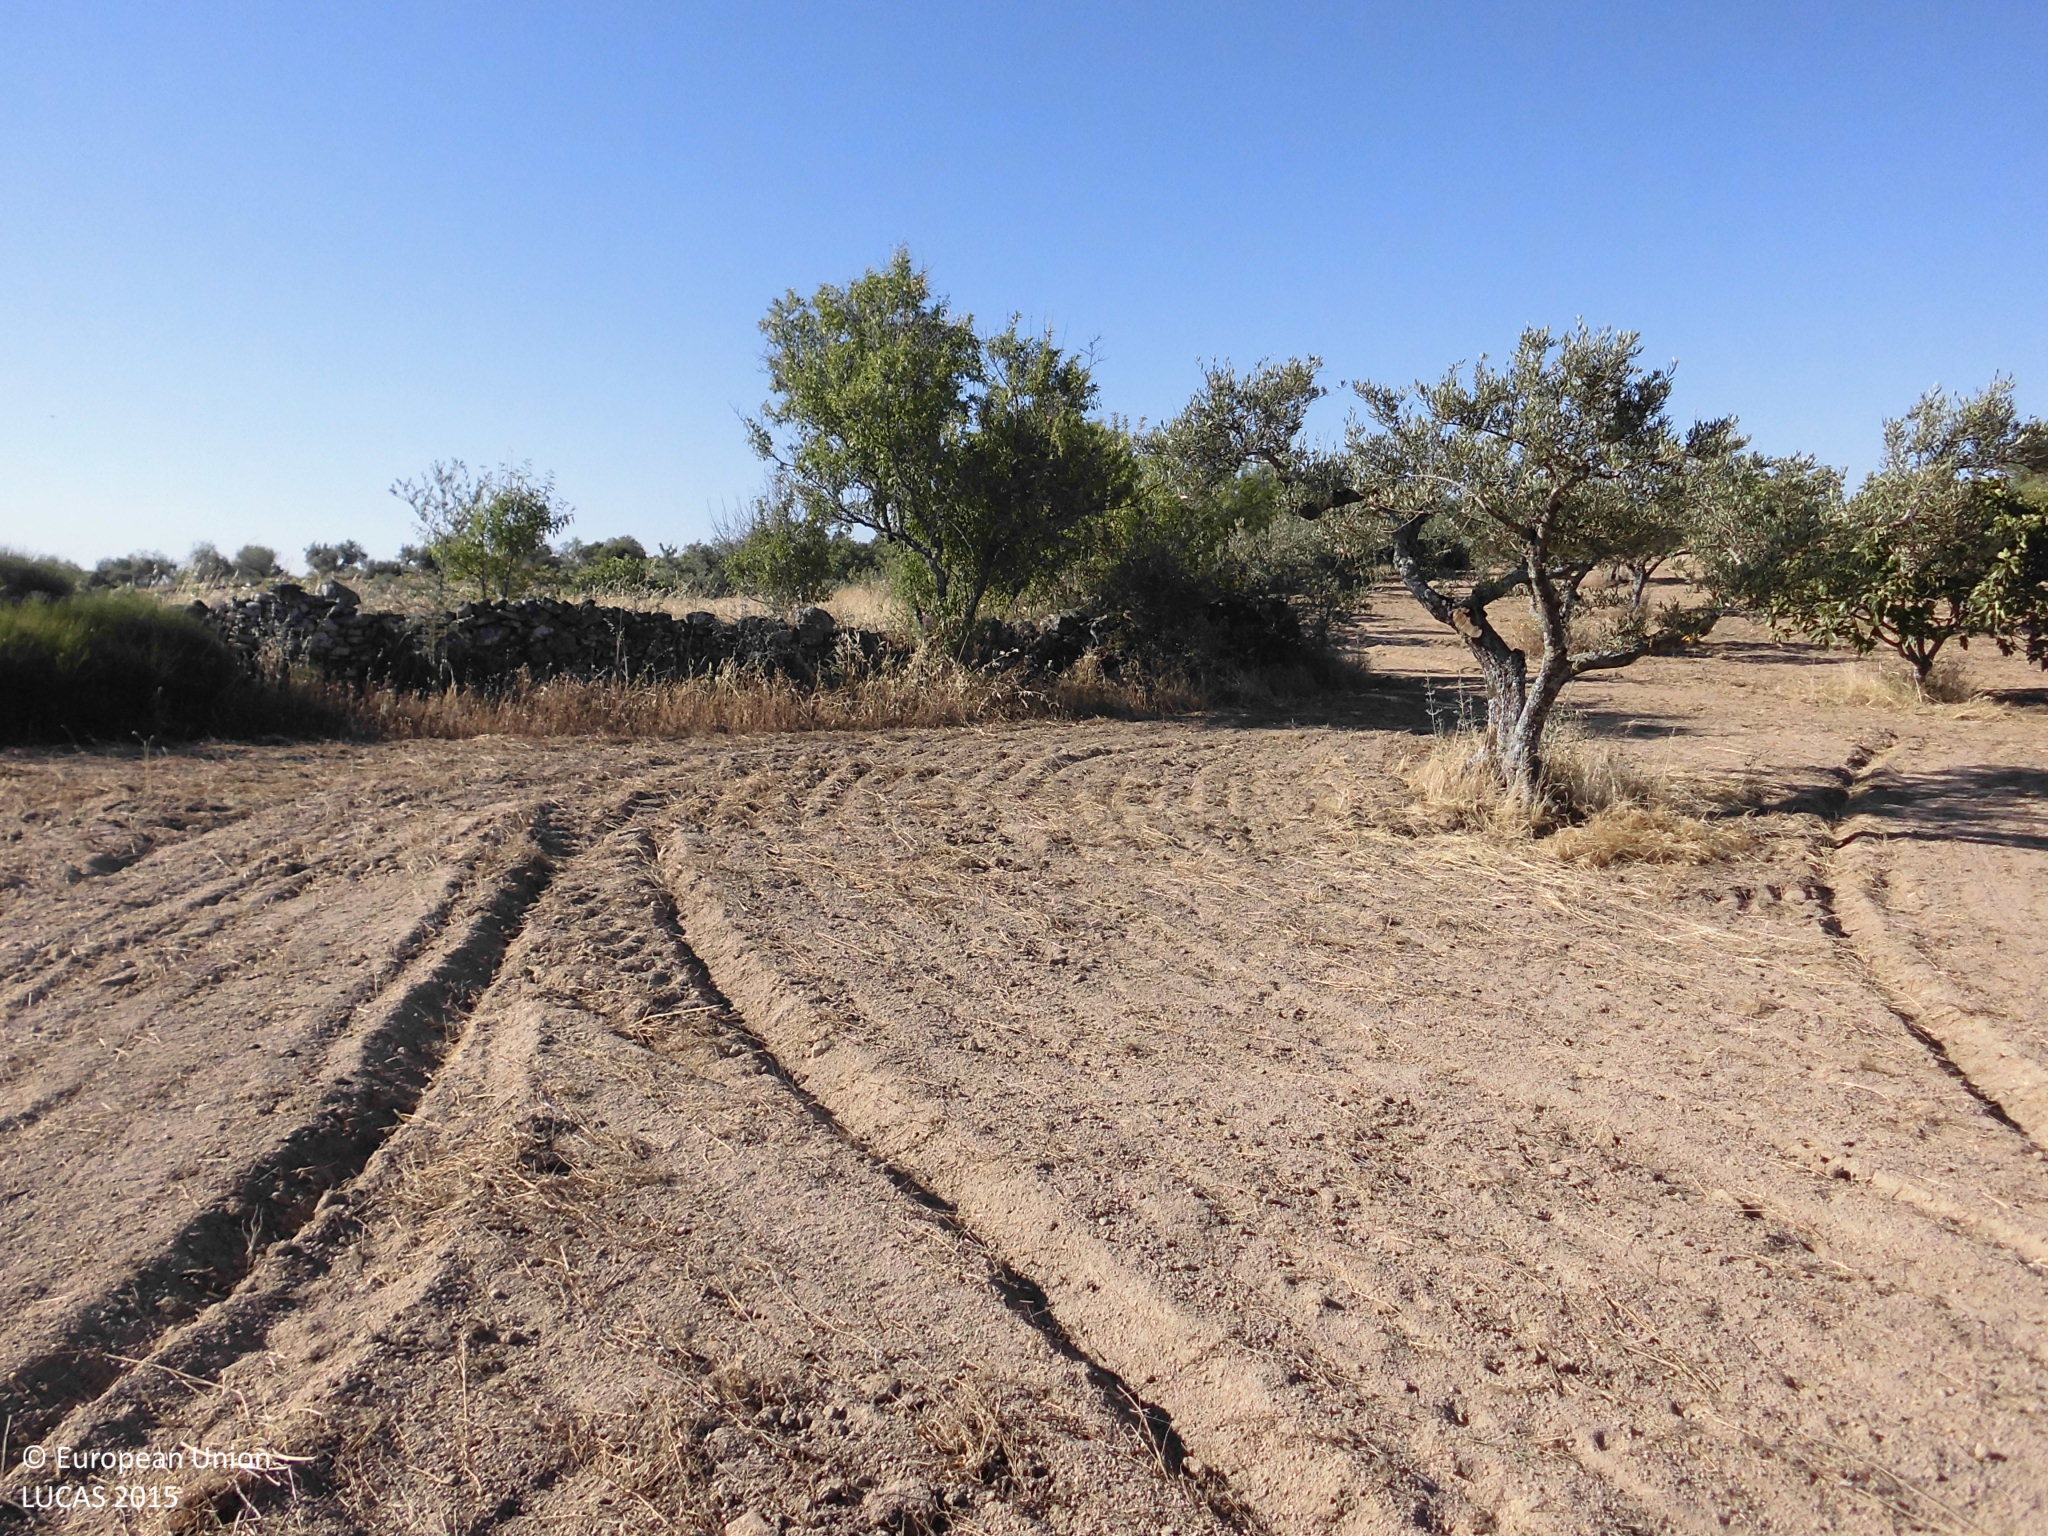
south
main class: Cropland
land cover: Other fruit trees and berries
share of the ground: 10 - 25 %
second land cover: Other bare soil
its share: > 75 %
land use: Agriculture (excluding fallow land and kitchen gardens)
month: May
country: ES
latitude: 39.8109
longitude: -6.7506
